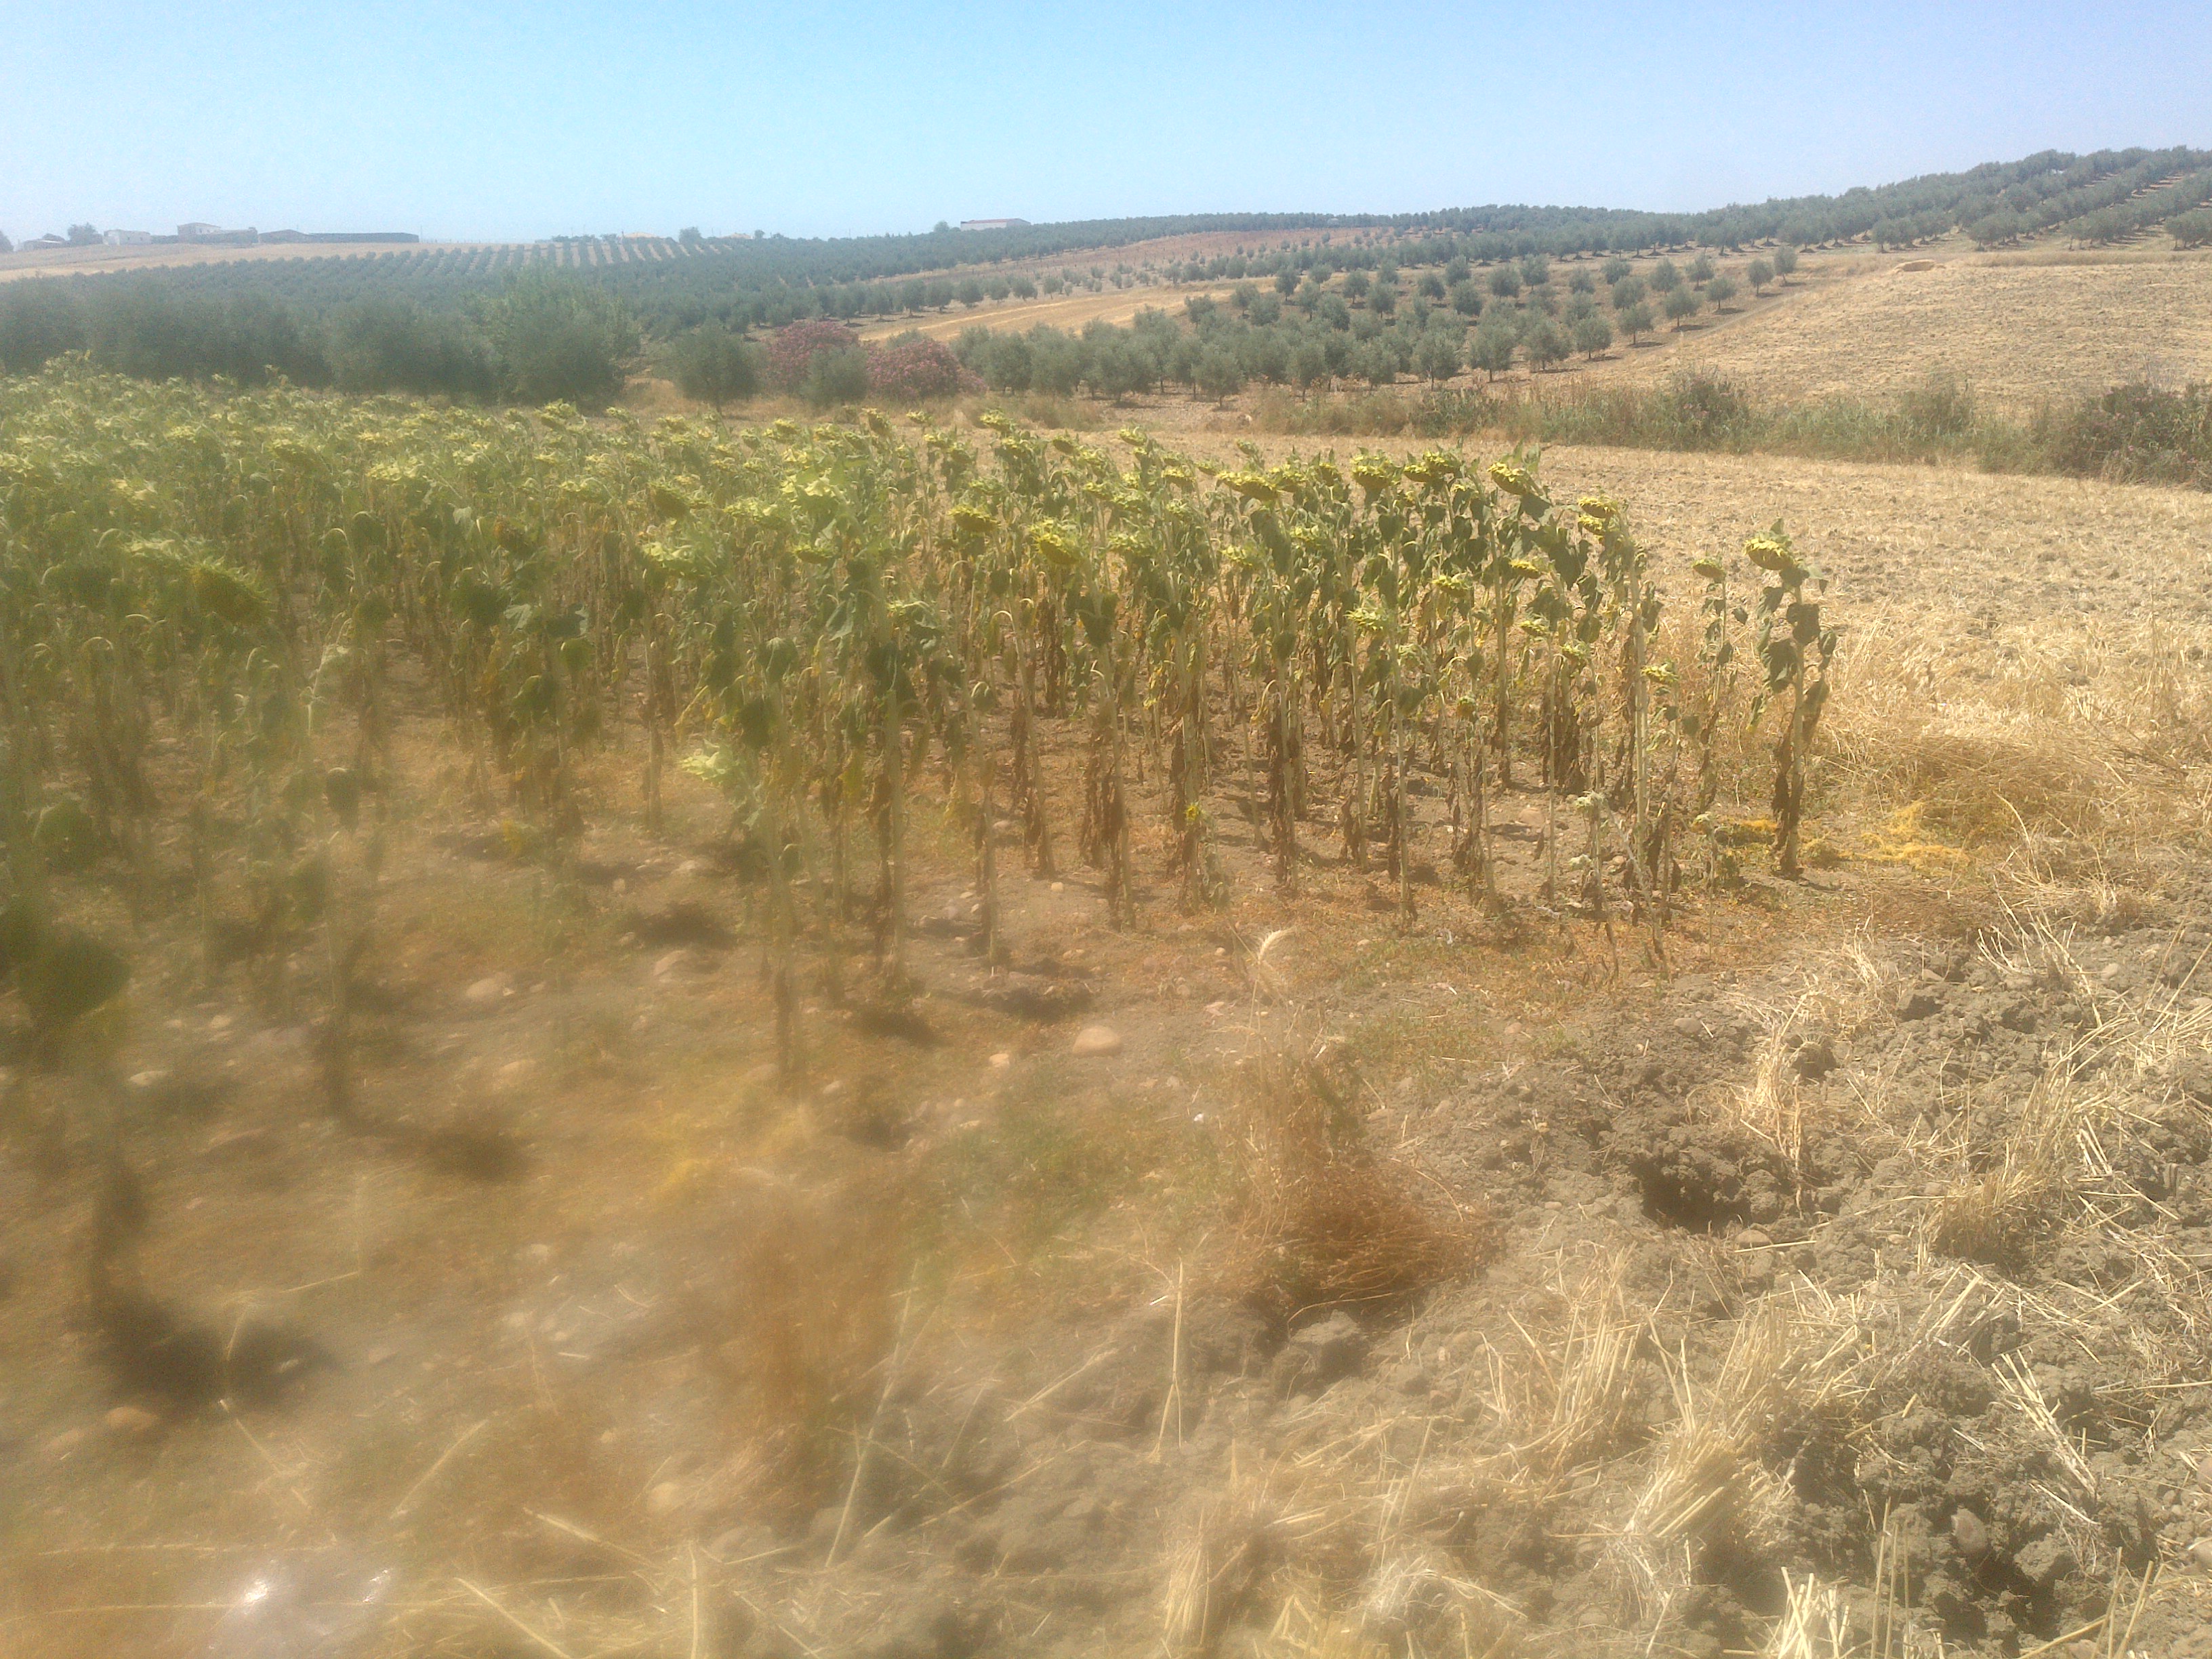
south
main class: Cropland
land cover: Durum wheat
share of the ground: < 10 %
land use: Agriculture (excluding fallow land and kitchen gardens)
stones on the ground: 10 - 25 %
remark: Harvested field
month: June
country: ES
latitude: 37.6708
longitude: -4.8984
